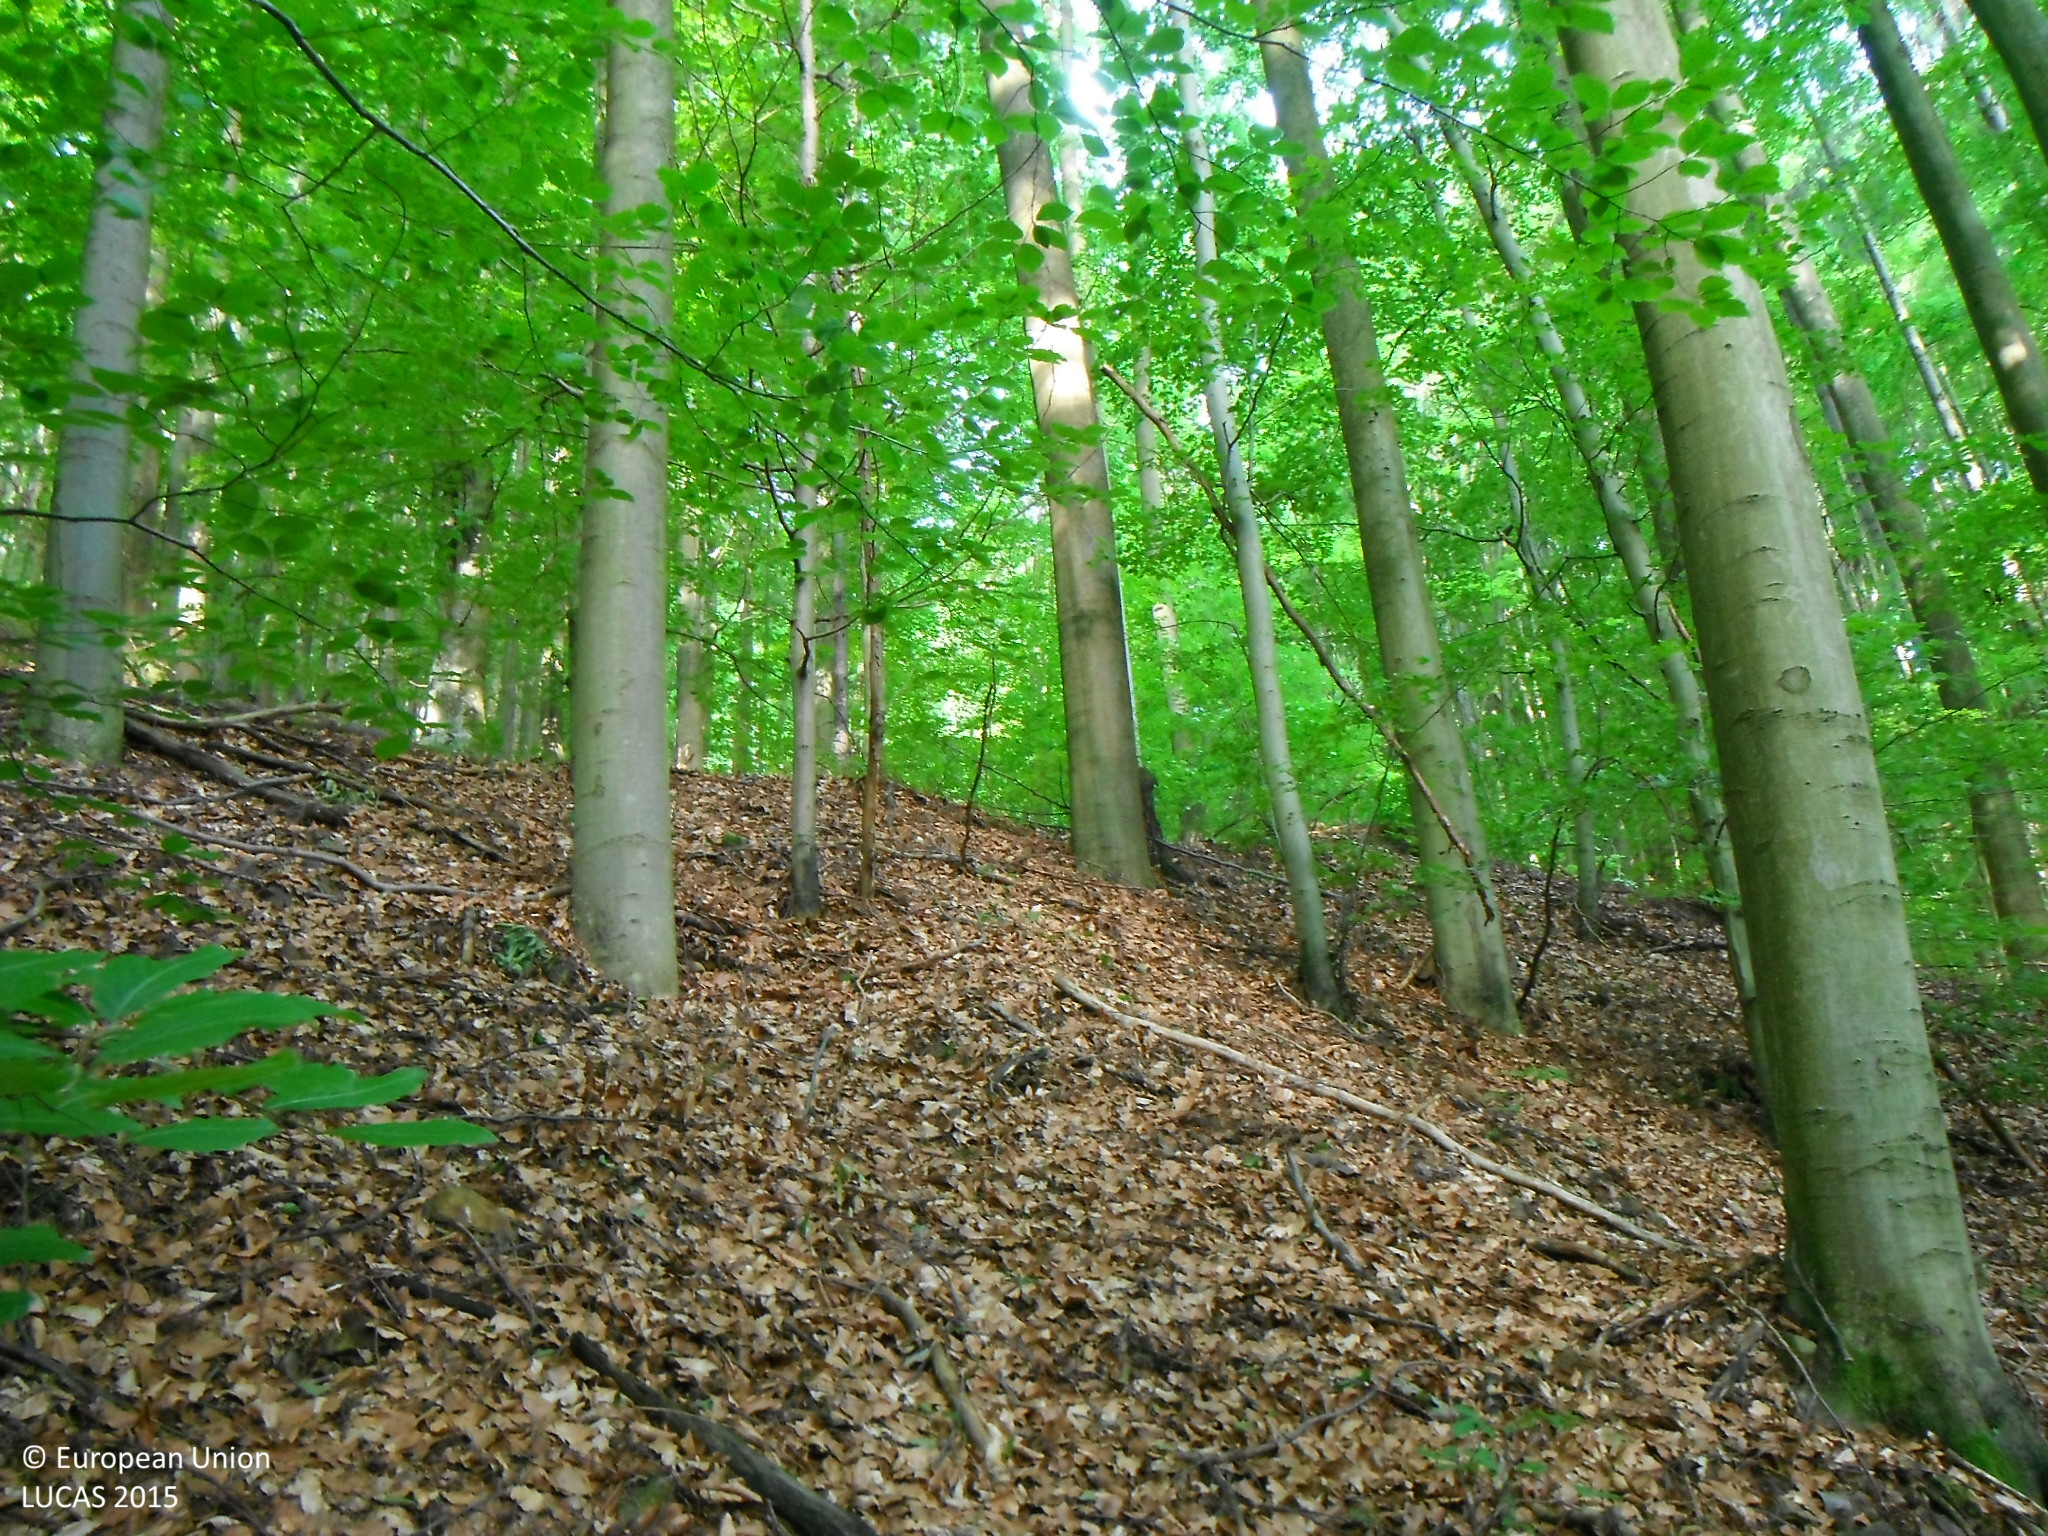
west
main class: Woodland
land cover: Broadleaved woodland
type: beech forest
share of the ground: > 75 %
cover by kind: broadleaved forest trees 100 %
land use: Forestry
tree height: > 5 m
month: June
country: SK
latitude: 48.4825
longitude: 19.2903
